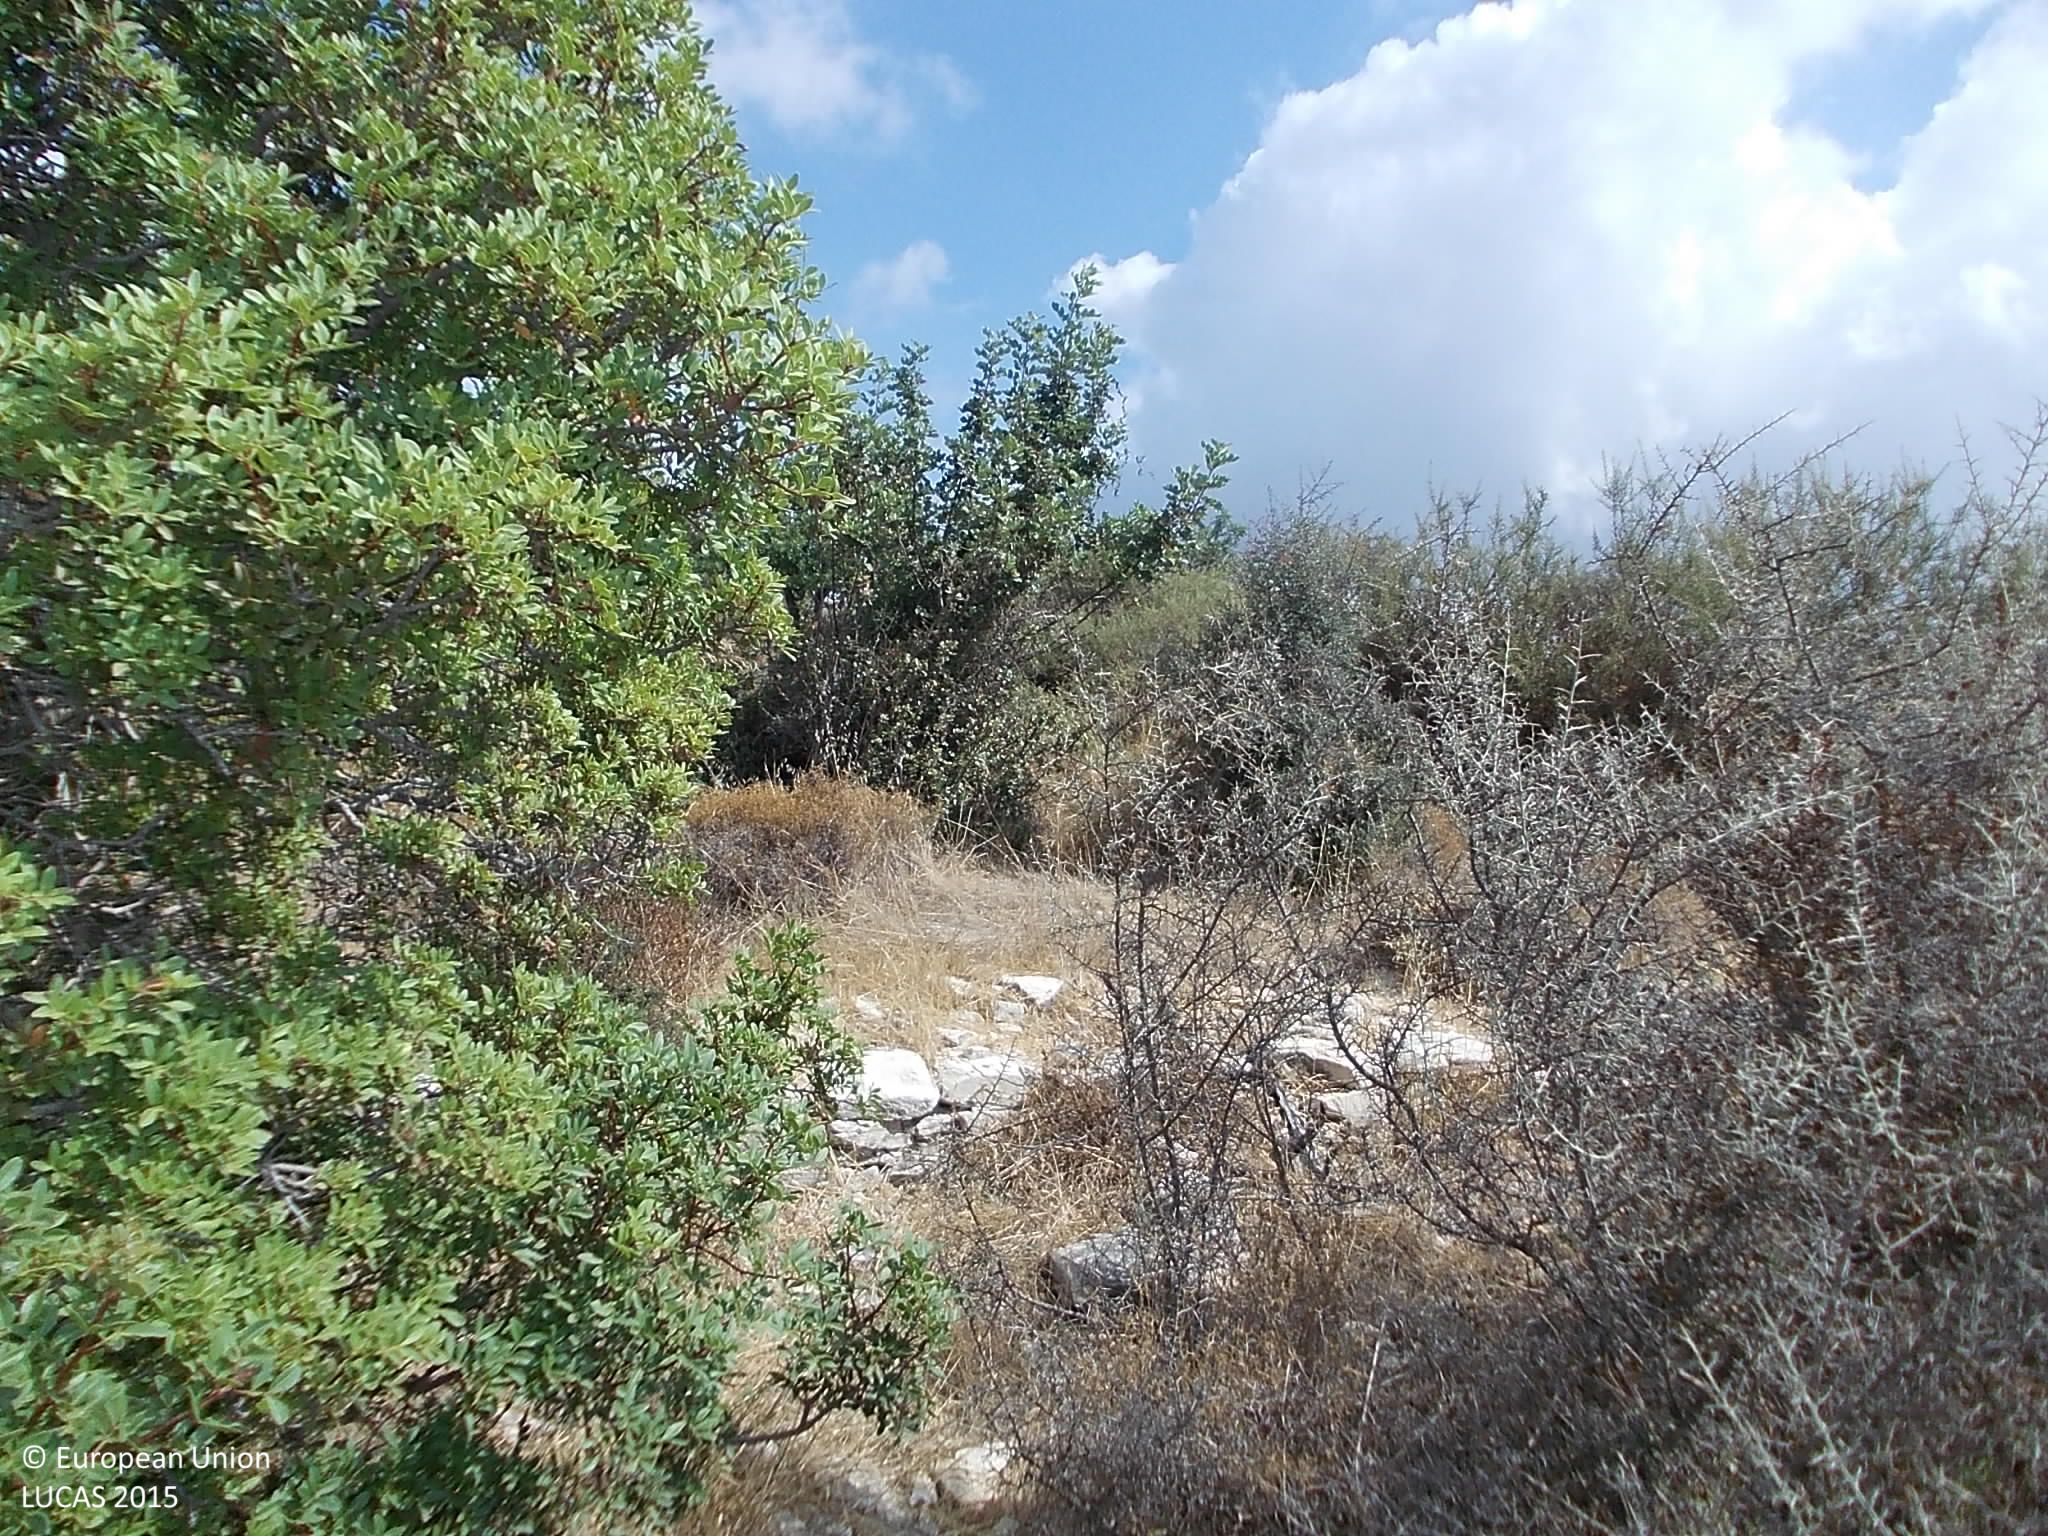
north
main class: Shrubland
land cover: Shrubland with sparse tree cover
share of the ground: > 75 %
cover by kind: shrubs 85 %, broadleaved forest trees 5 %, herbaceous plants 5 %, unconsolidated bare surface 5 %
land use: Semi-natural and natural areas not in use
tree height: < 5 m
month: August
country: CY
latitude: 34.7023
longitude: 32.6967
